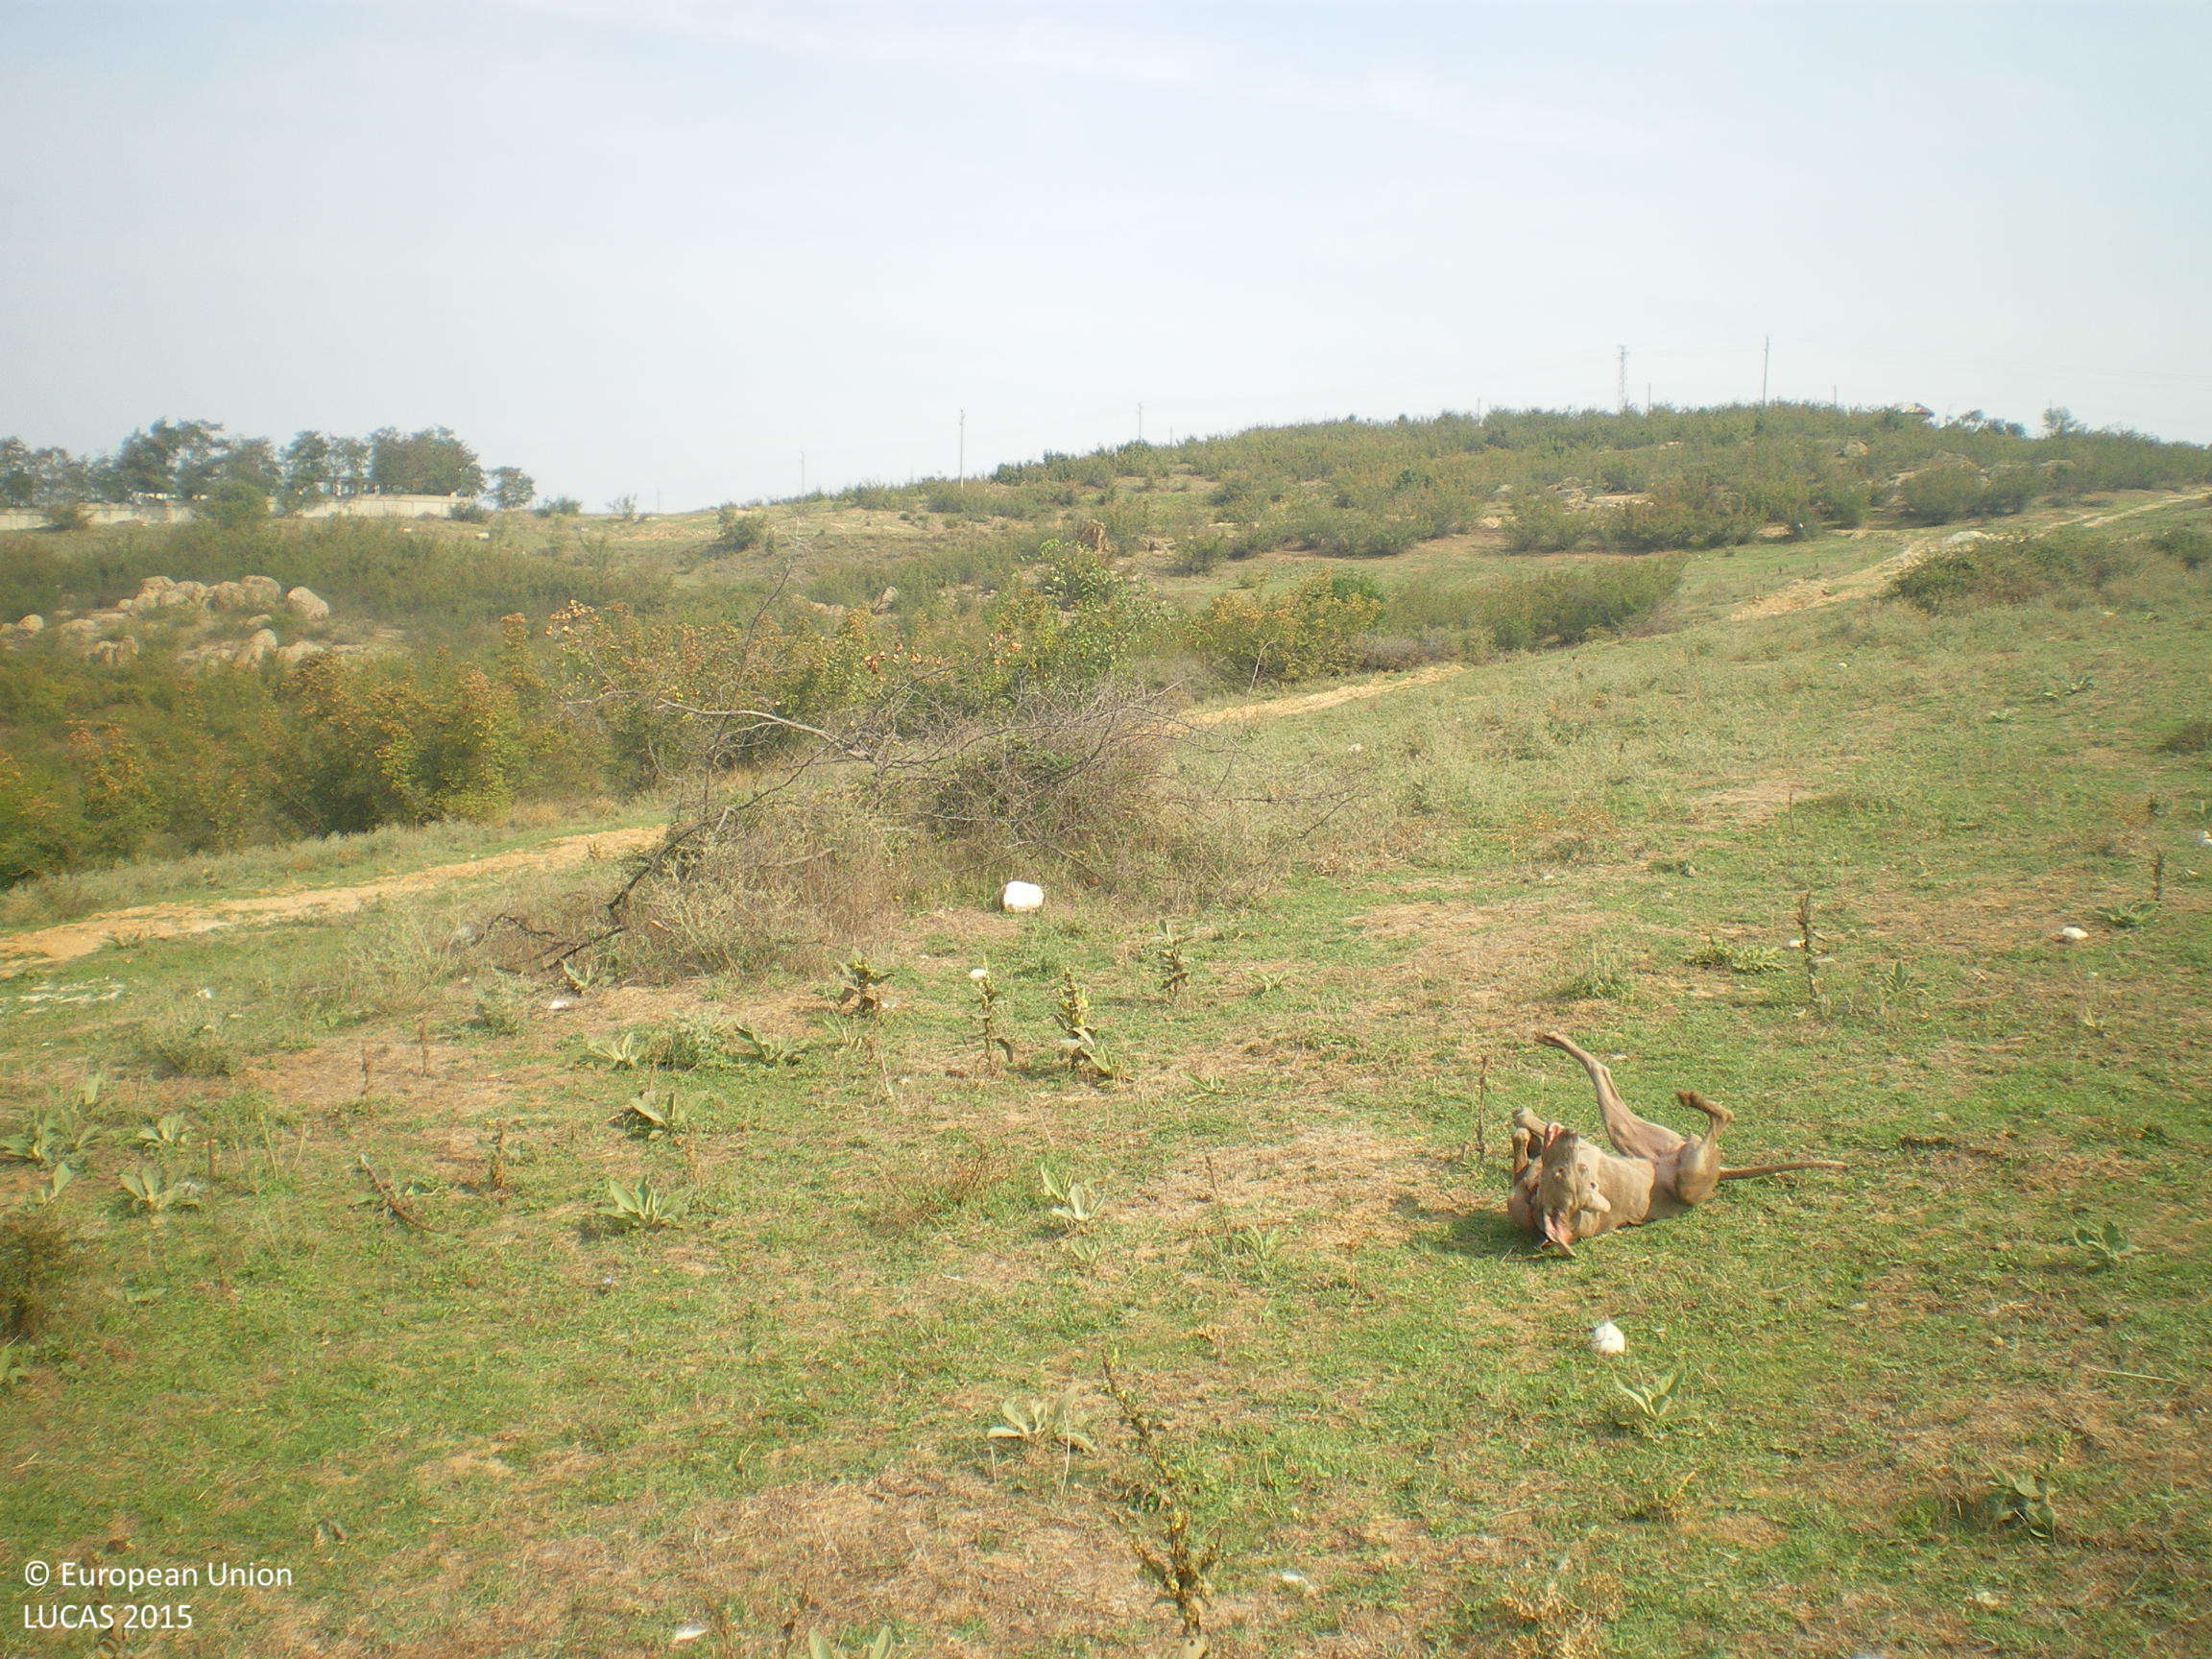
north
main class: Grassland
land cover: Grassland without tree/shrub cover
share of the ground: > 75 %
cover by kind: herbaceous plants 100 %
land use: Agriculture (excluding fallow land and kitchen gardens)
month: September
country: BG
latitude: 41.9033
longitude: 25.8986
